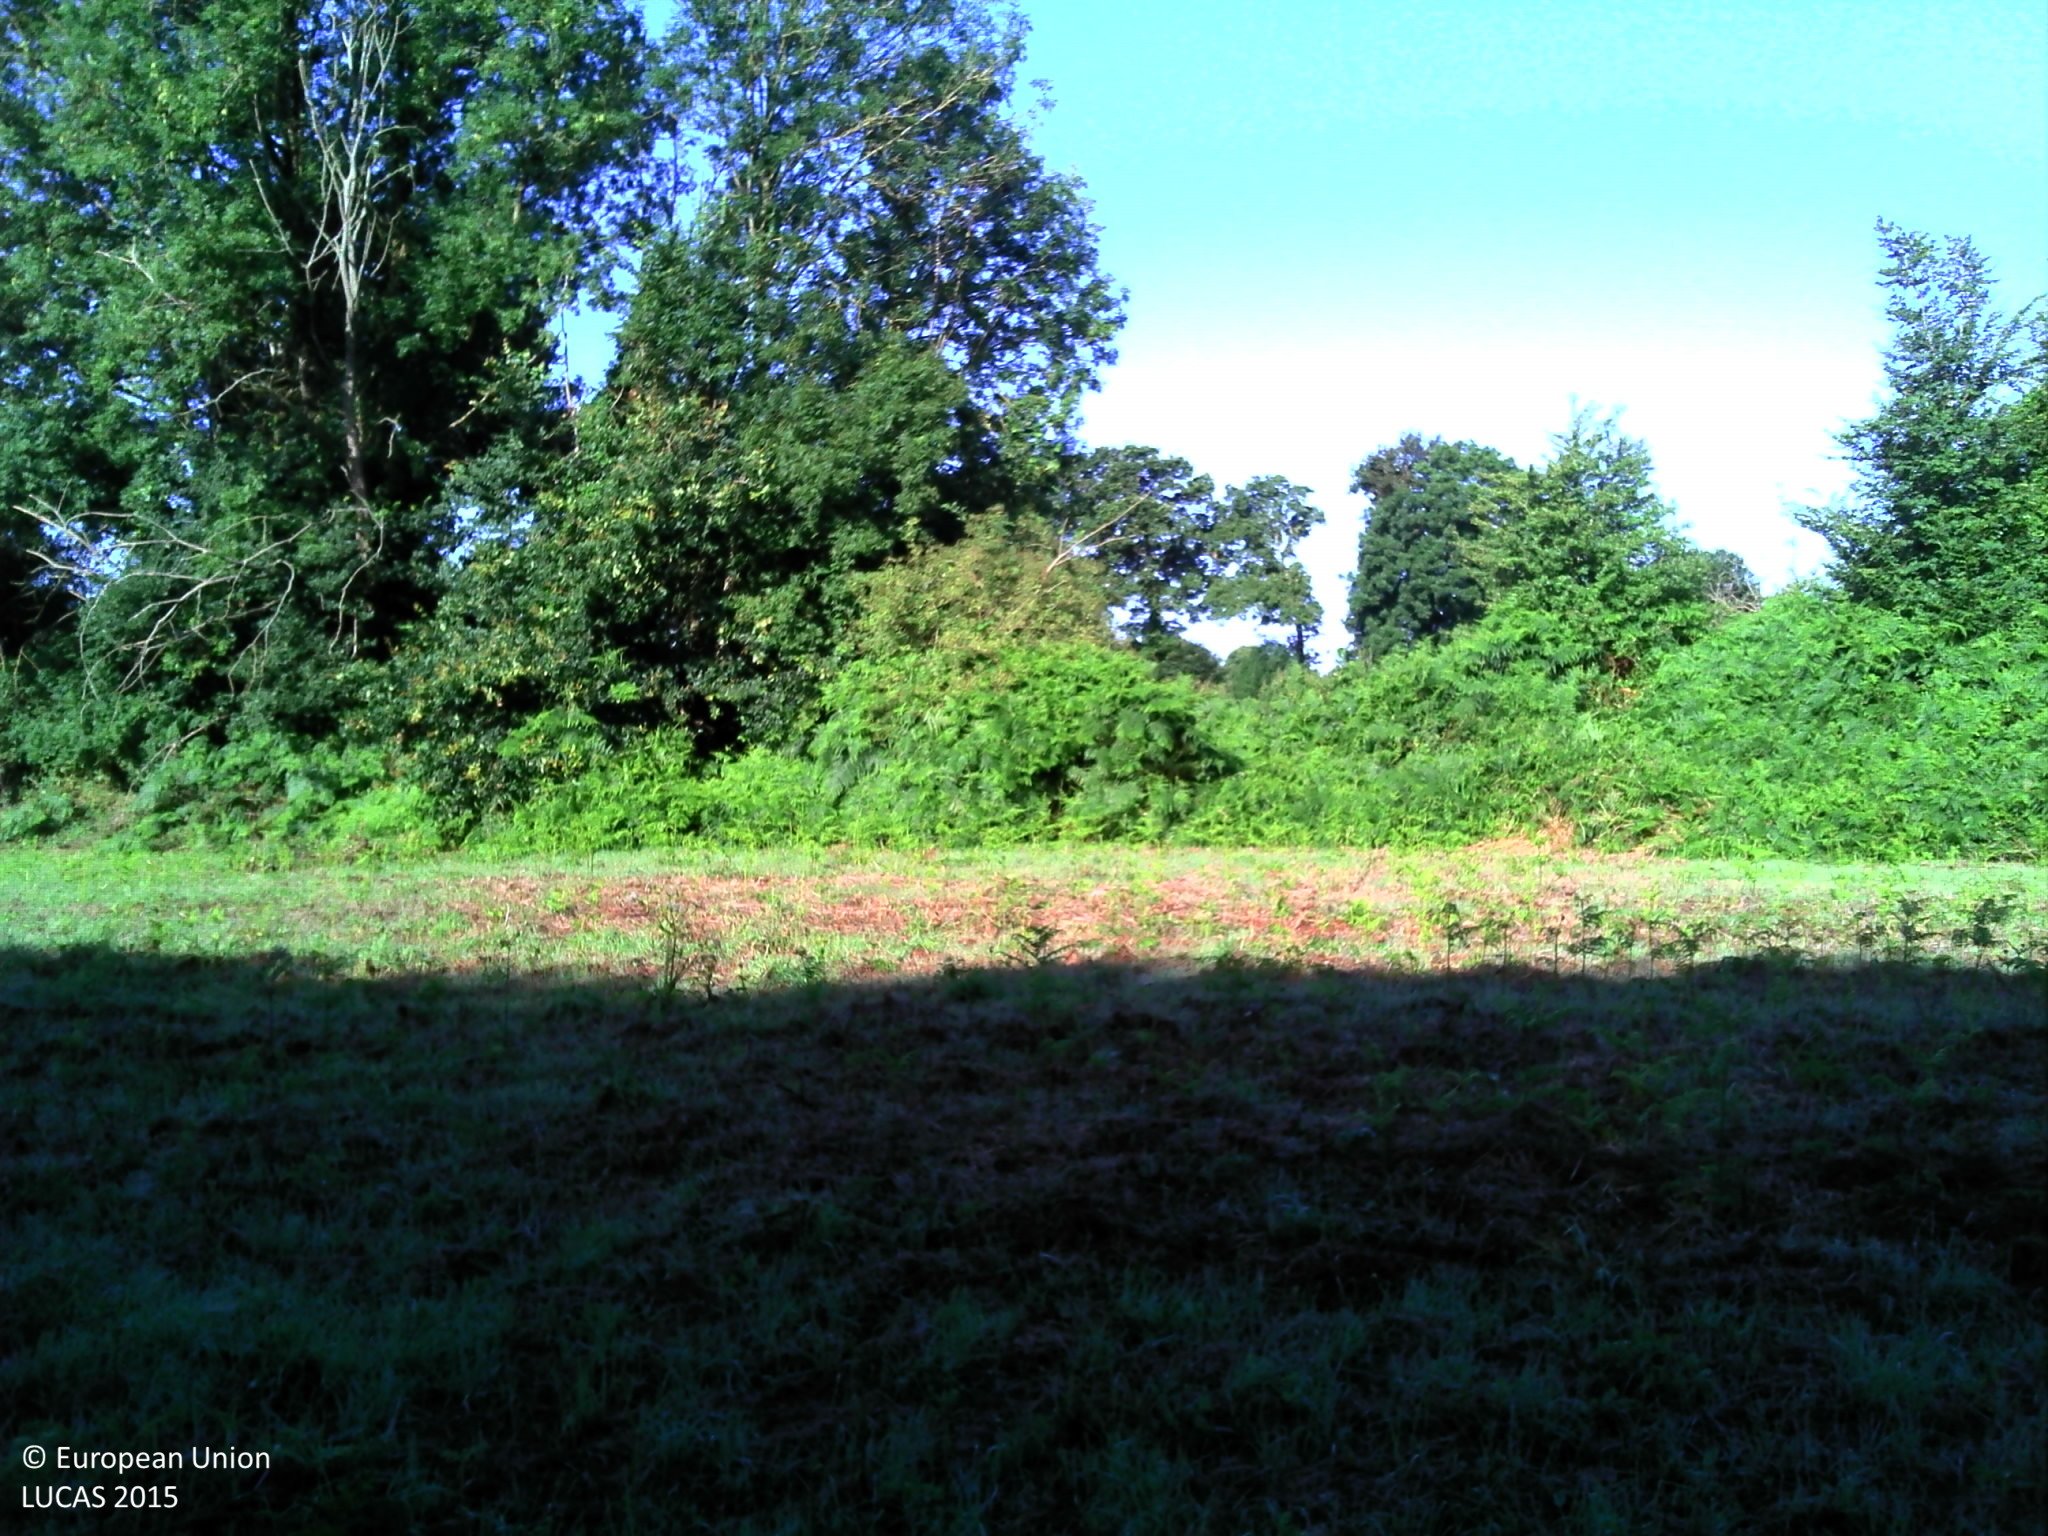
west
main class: Woodland
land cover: Broadleaved woodland
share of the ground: > 75 %
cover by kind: broadleaved forest trees 90 %, herbaceous plants 10 %
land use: Semi-natural and natural areas not in use
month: July
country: FR
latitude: 48.1621
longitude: -3.2897
